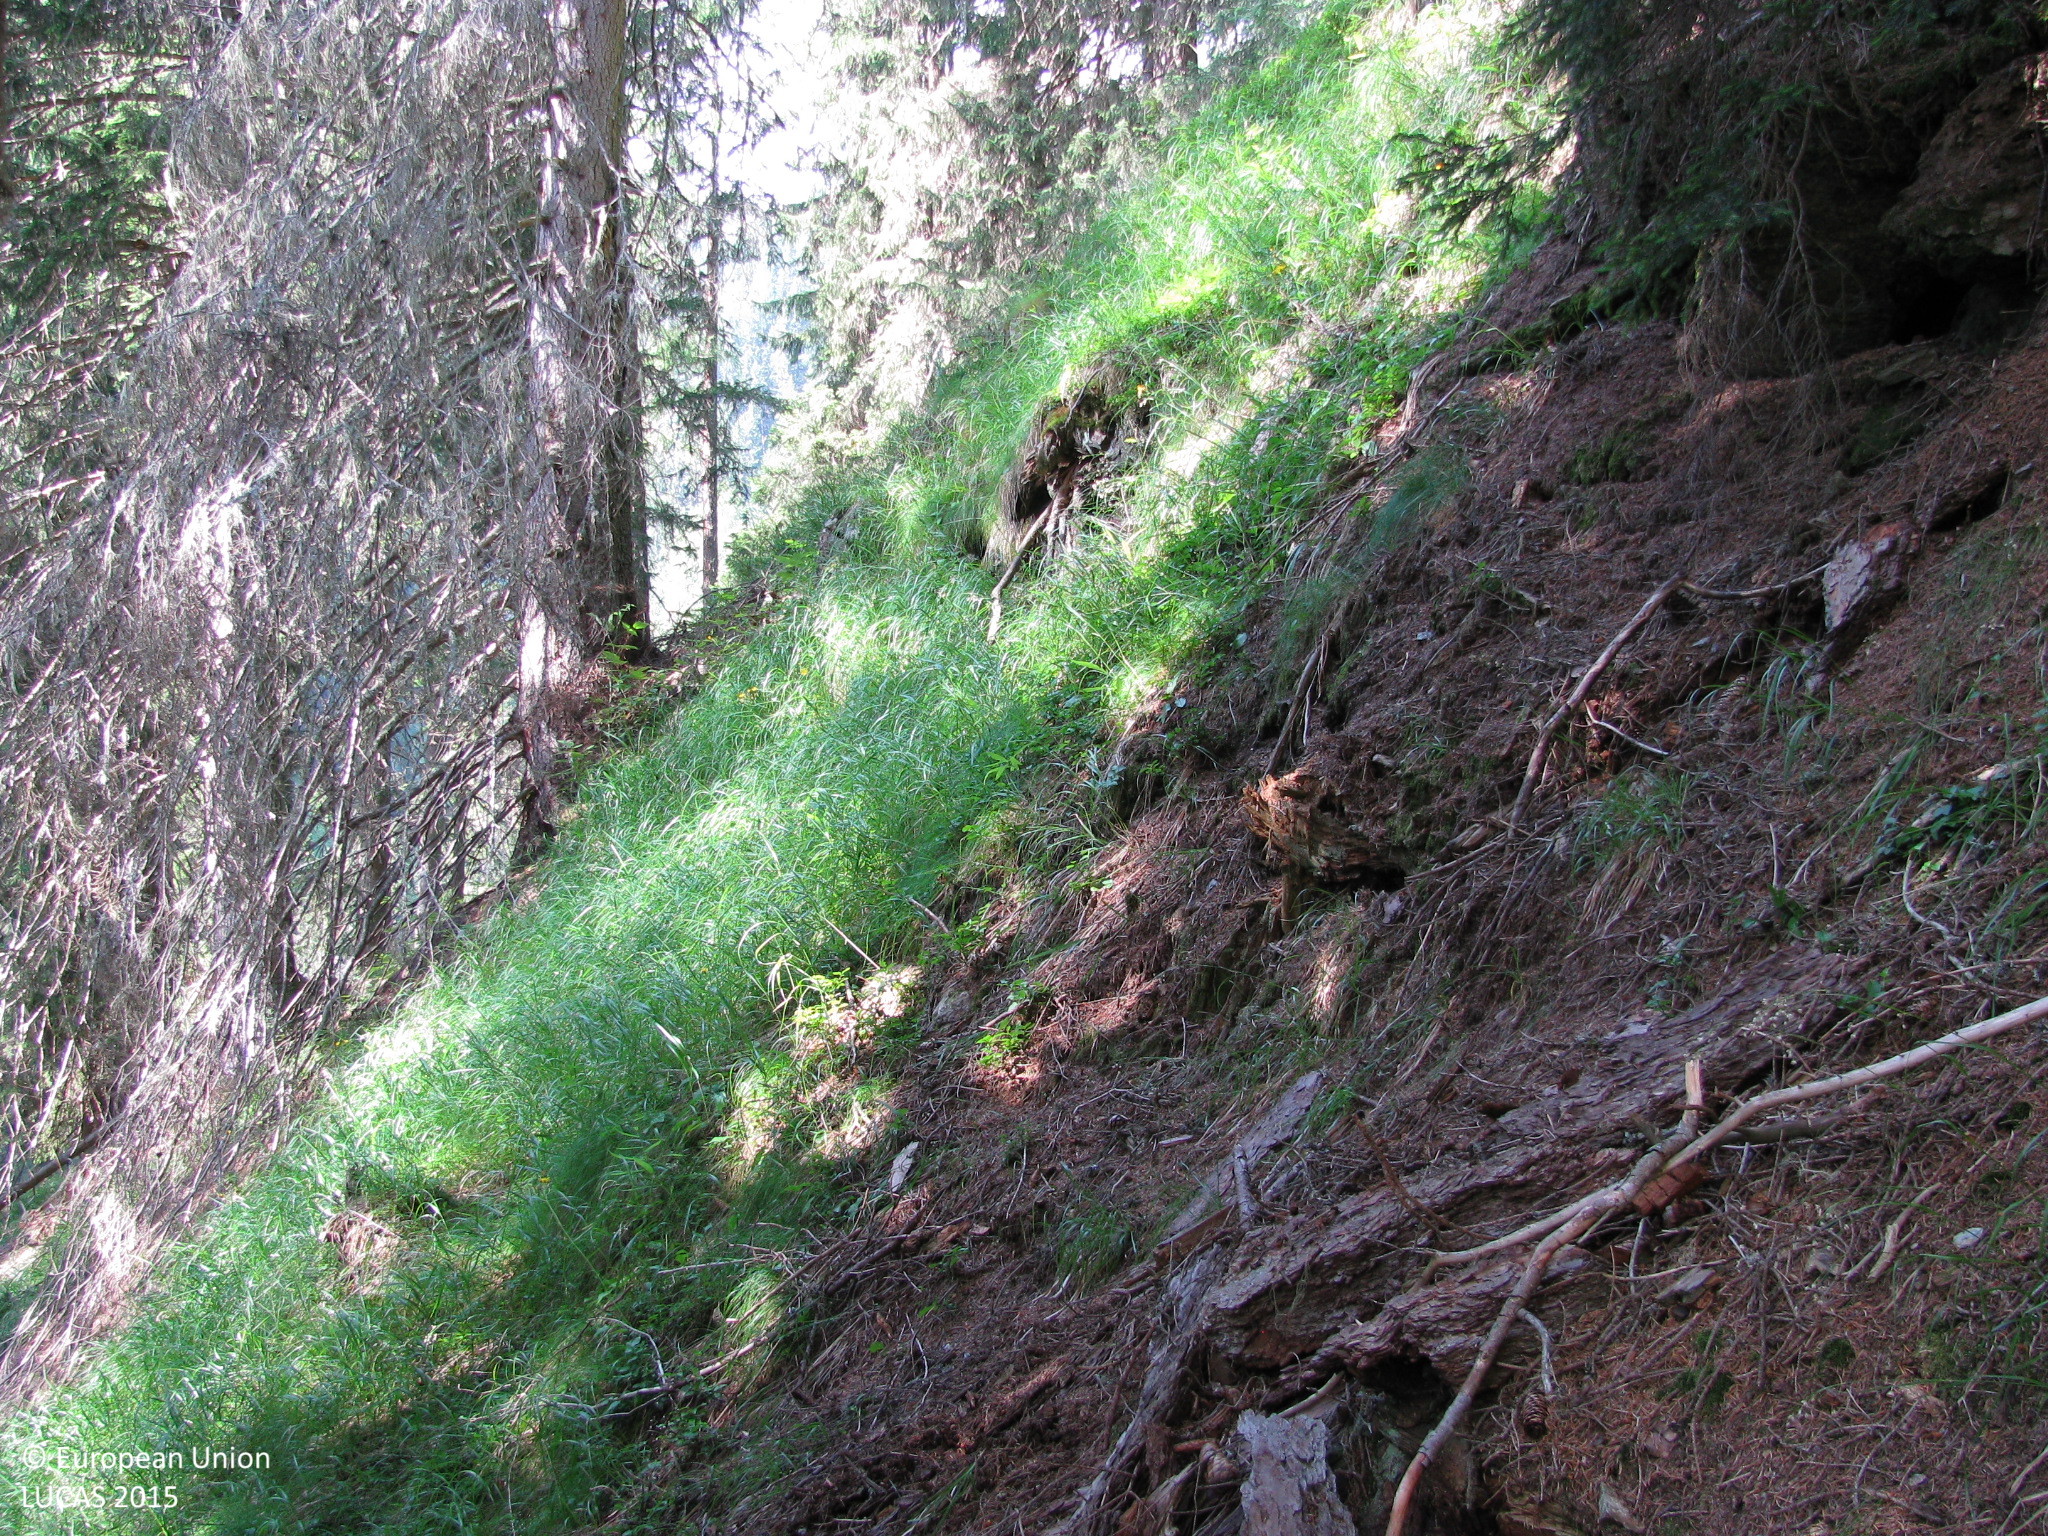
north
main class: Woodland
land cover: Spruce dominated coniferous woodland
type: alpine coniferous forest
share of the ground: > 75 %
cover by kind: coniferous forest trees 85 %, herbaceous plants 10 %, unconsolidated bare surface 5 %
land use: Forestry
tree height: > 5 m
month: July
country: AT
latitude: 46.7160
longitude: 12.6008
